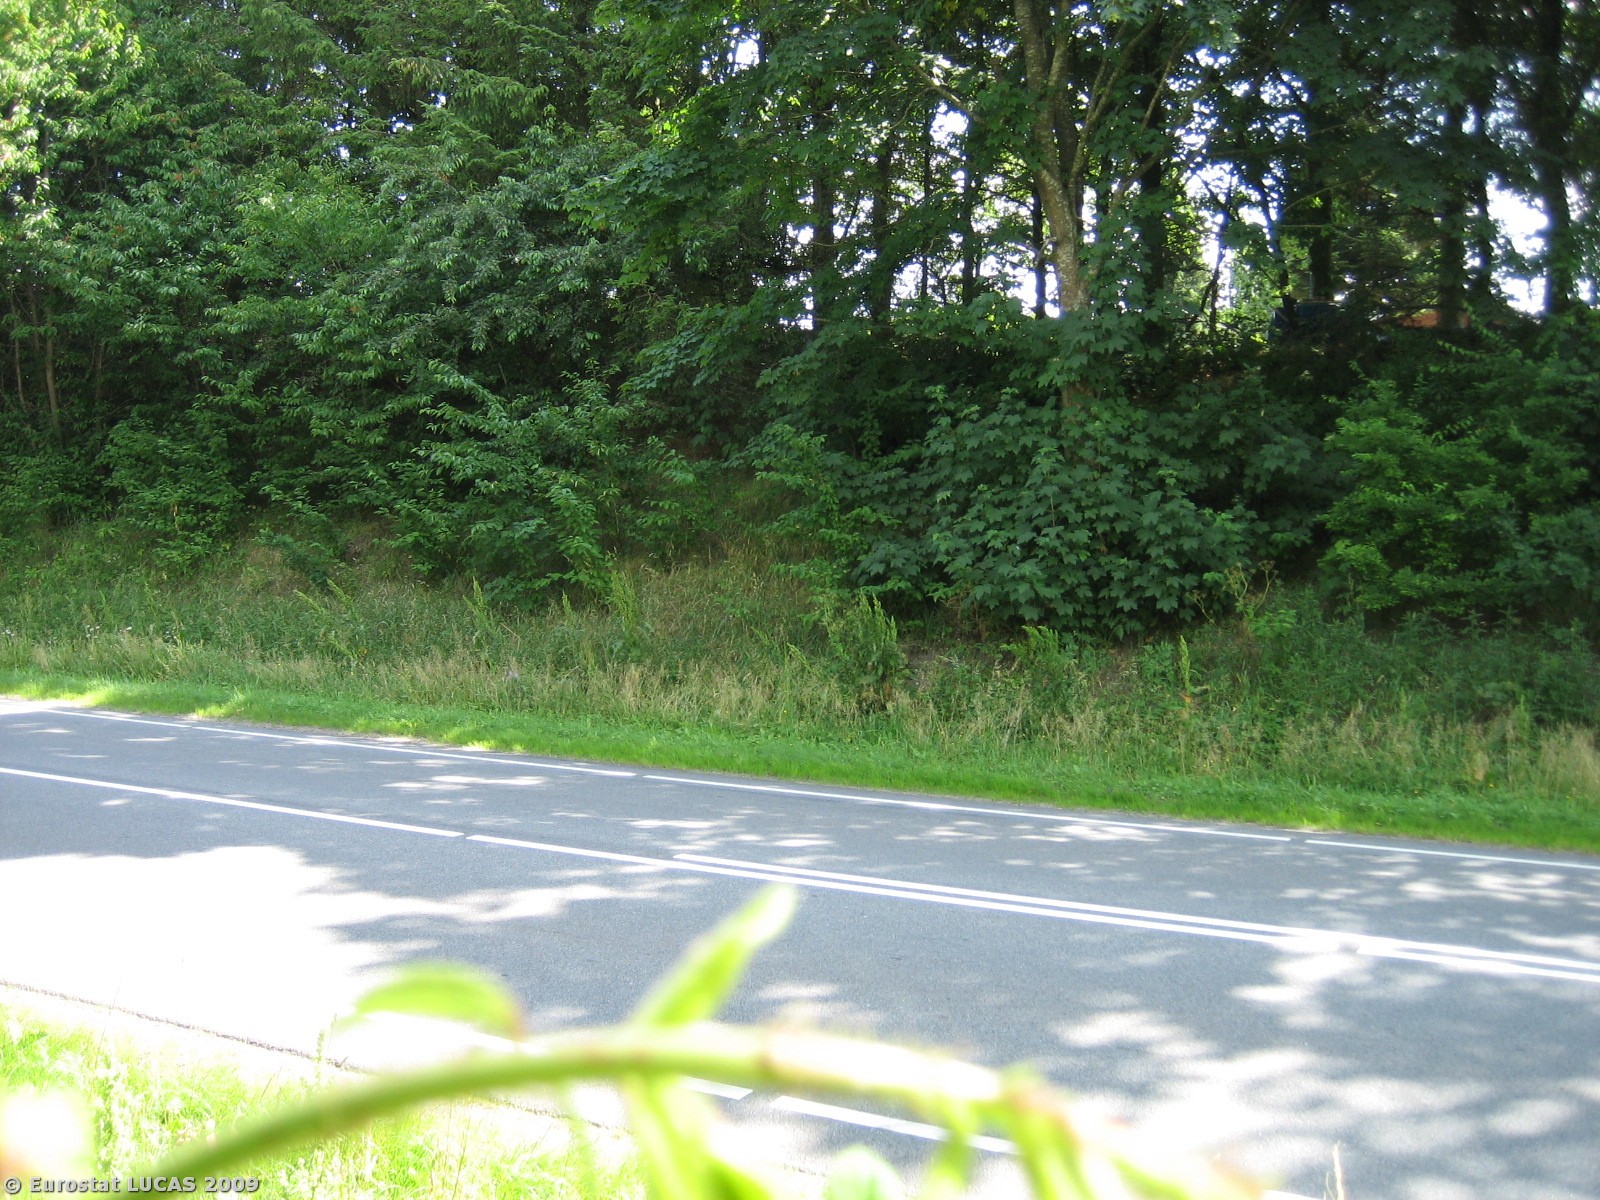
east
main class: Woodland
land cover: Broadleaved woodland
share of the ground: > 75 %
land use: Unused
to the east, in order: Broadleaved woodland; Spontaneously vegetated surfaces; Ditches and canals; Grass margins; Paved roads, cycling and walking lanes; Grass margins; Broadleaved woodland; Grassland without tree/shrub cover; Artificial constructions in urban areas
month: July
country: DK
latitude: 55.6081
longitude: 8.9374
